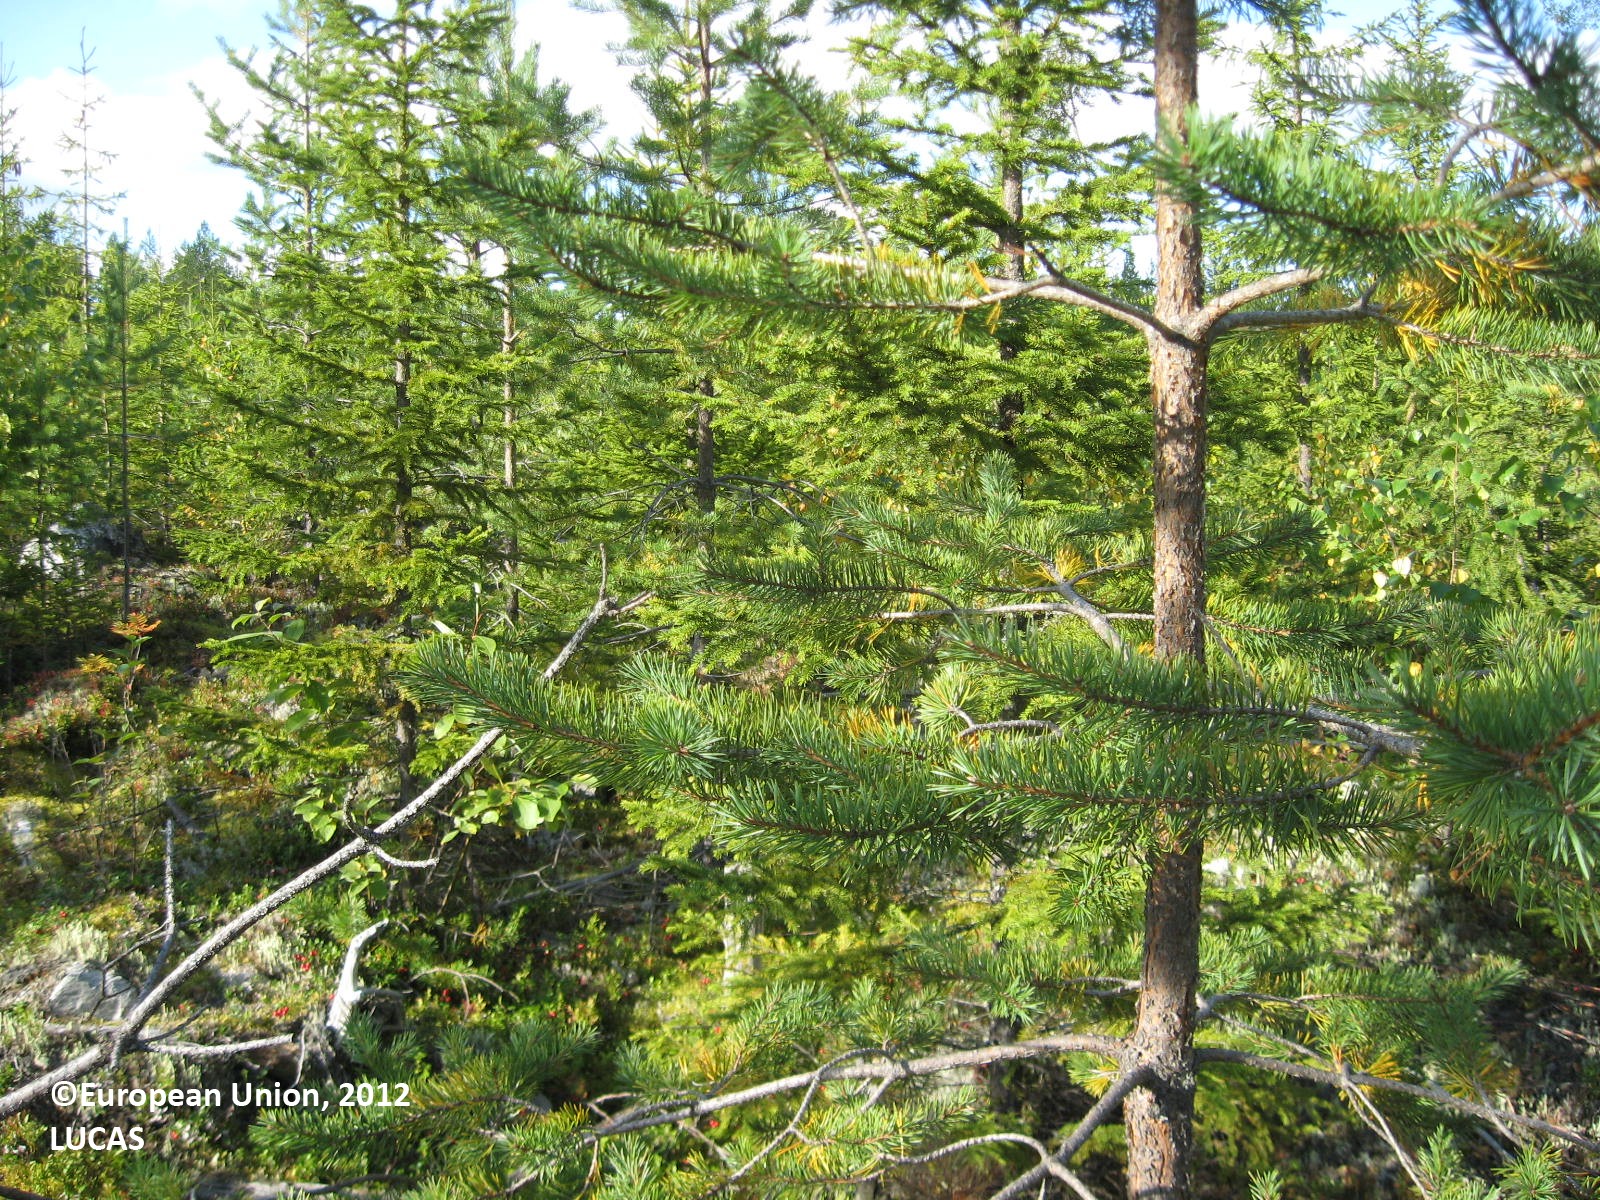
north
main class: Woodland
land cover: Spruce dominated coniferous woodland
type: boreal forest
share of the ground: > 75 %
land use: Forestry
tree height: < 5 m
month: August
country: FI
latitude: 63.9547
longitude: 29.9374
